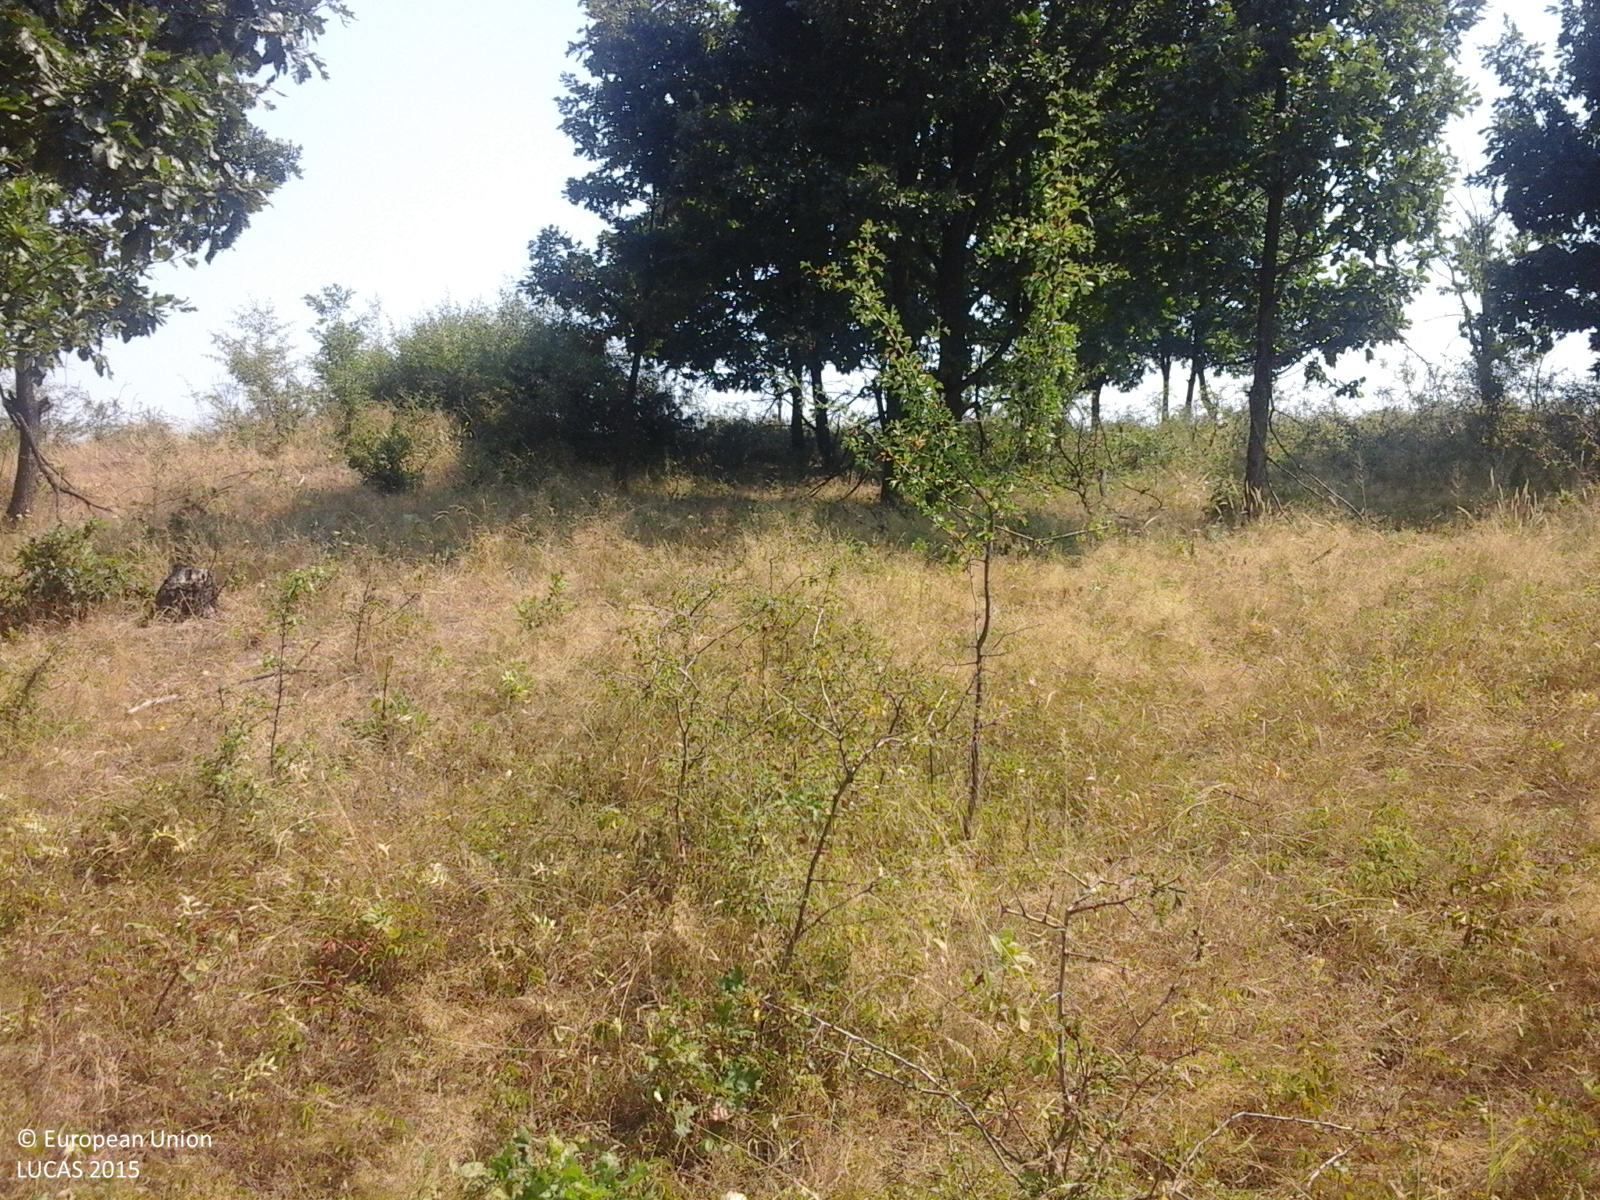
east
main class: Grassland
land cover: Grassland with sparse tree/shrub cover
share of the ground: > 75 %
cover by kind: herbaceous plants 85 %, shrubs 10 %, broadleaved forest trees 5 %
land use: Agriculture (excluding fallow land and kitchen gardens)
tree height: > 5 m
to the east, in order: Grassland with sparse tree/shrub cover; Shrubland with sparse tree cover; Broadleaved woodland
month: August
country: RO
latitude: 44.6009
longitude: 23.0361
